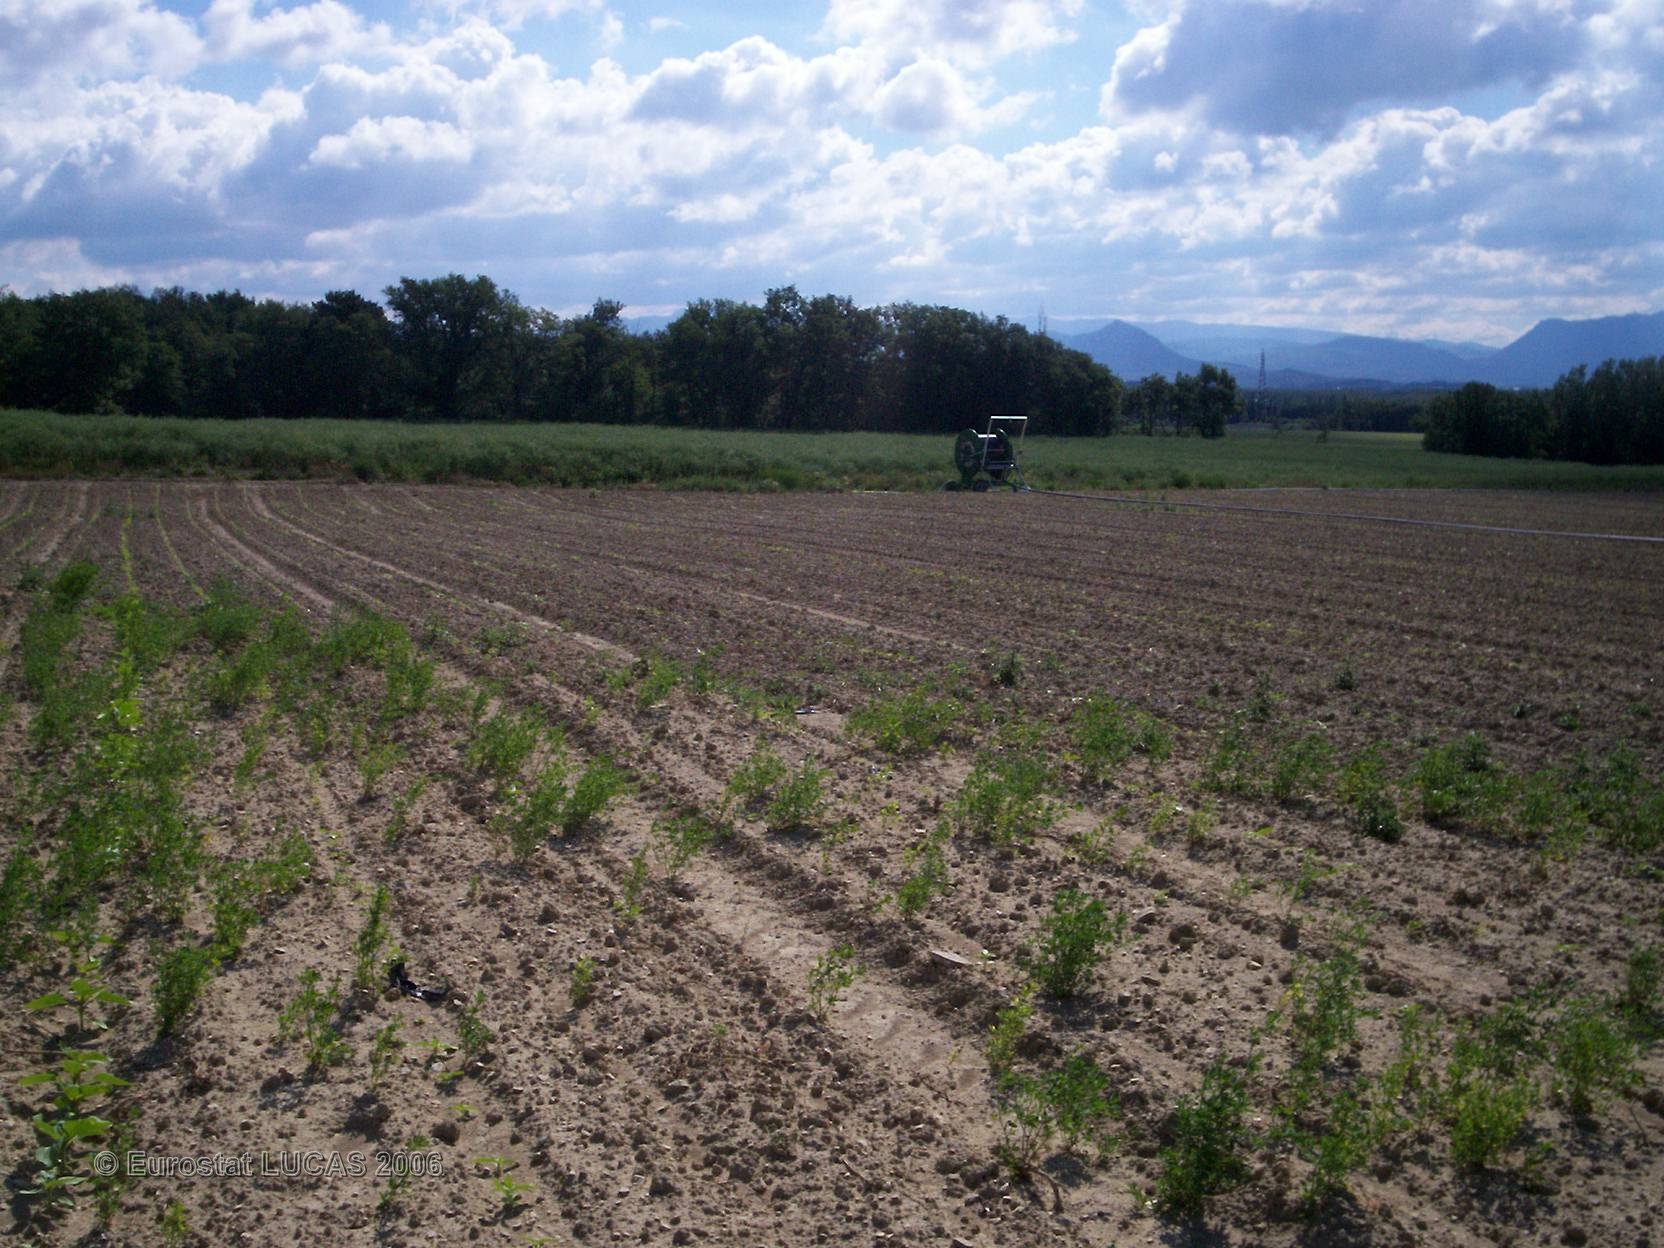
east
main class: Cropland
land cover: Sunflower
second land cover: Lucerne
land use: Agriculture (excluding fallow land and kitchen gardens)
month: May
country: FR
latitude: 44.6215
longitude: 4.8771
